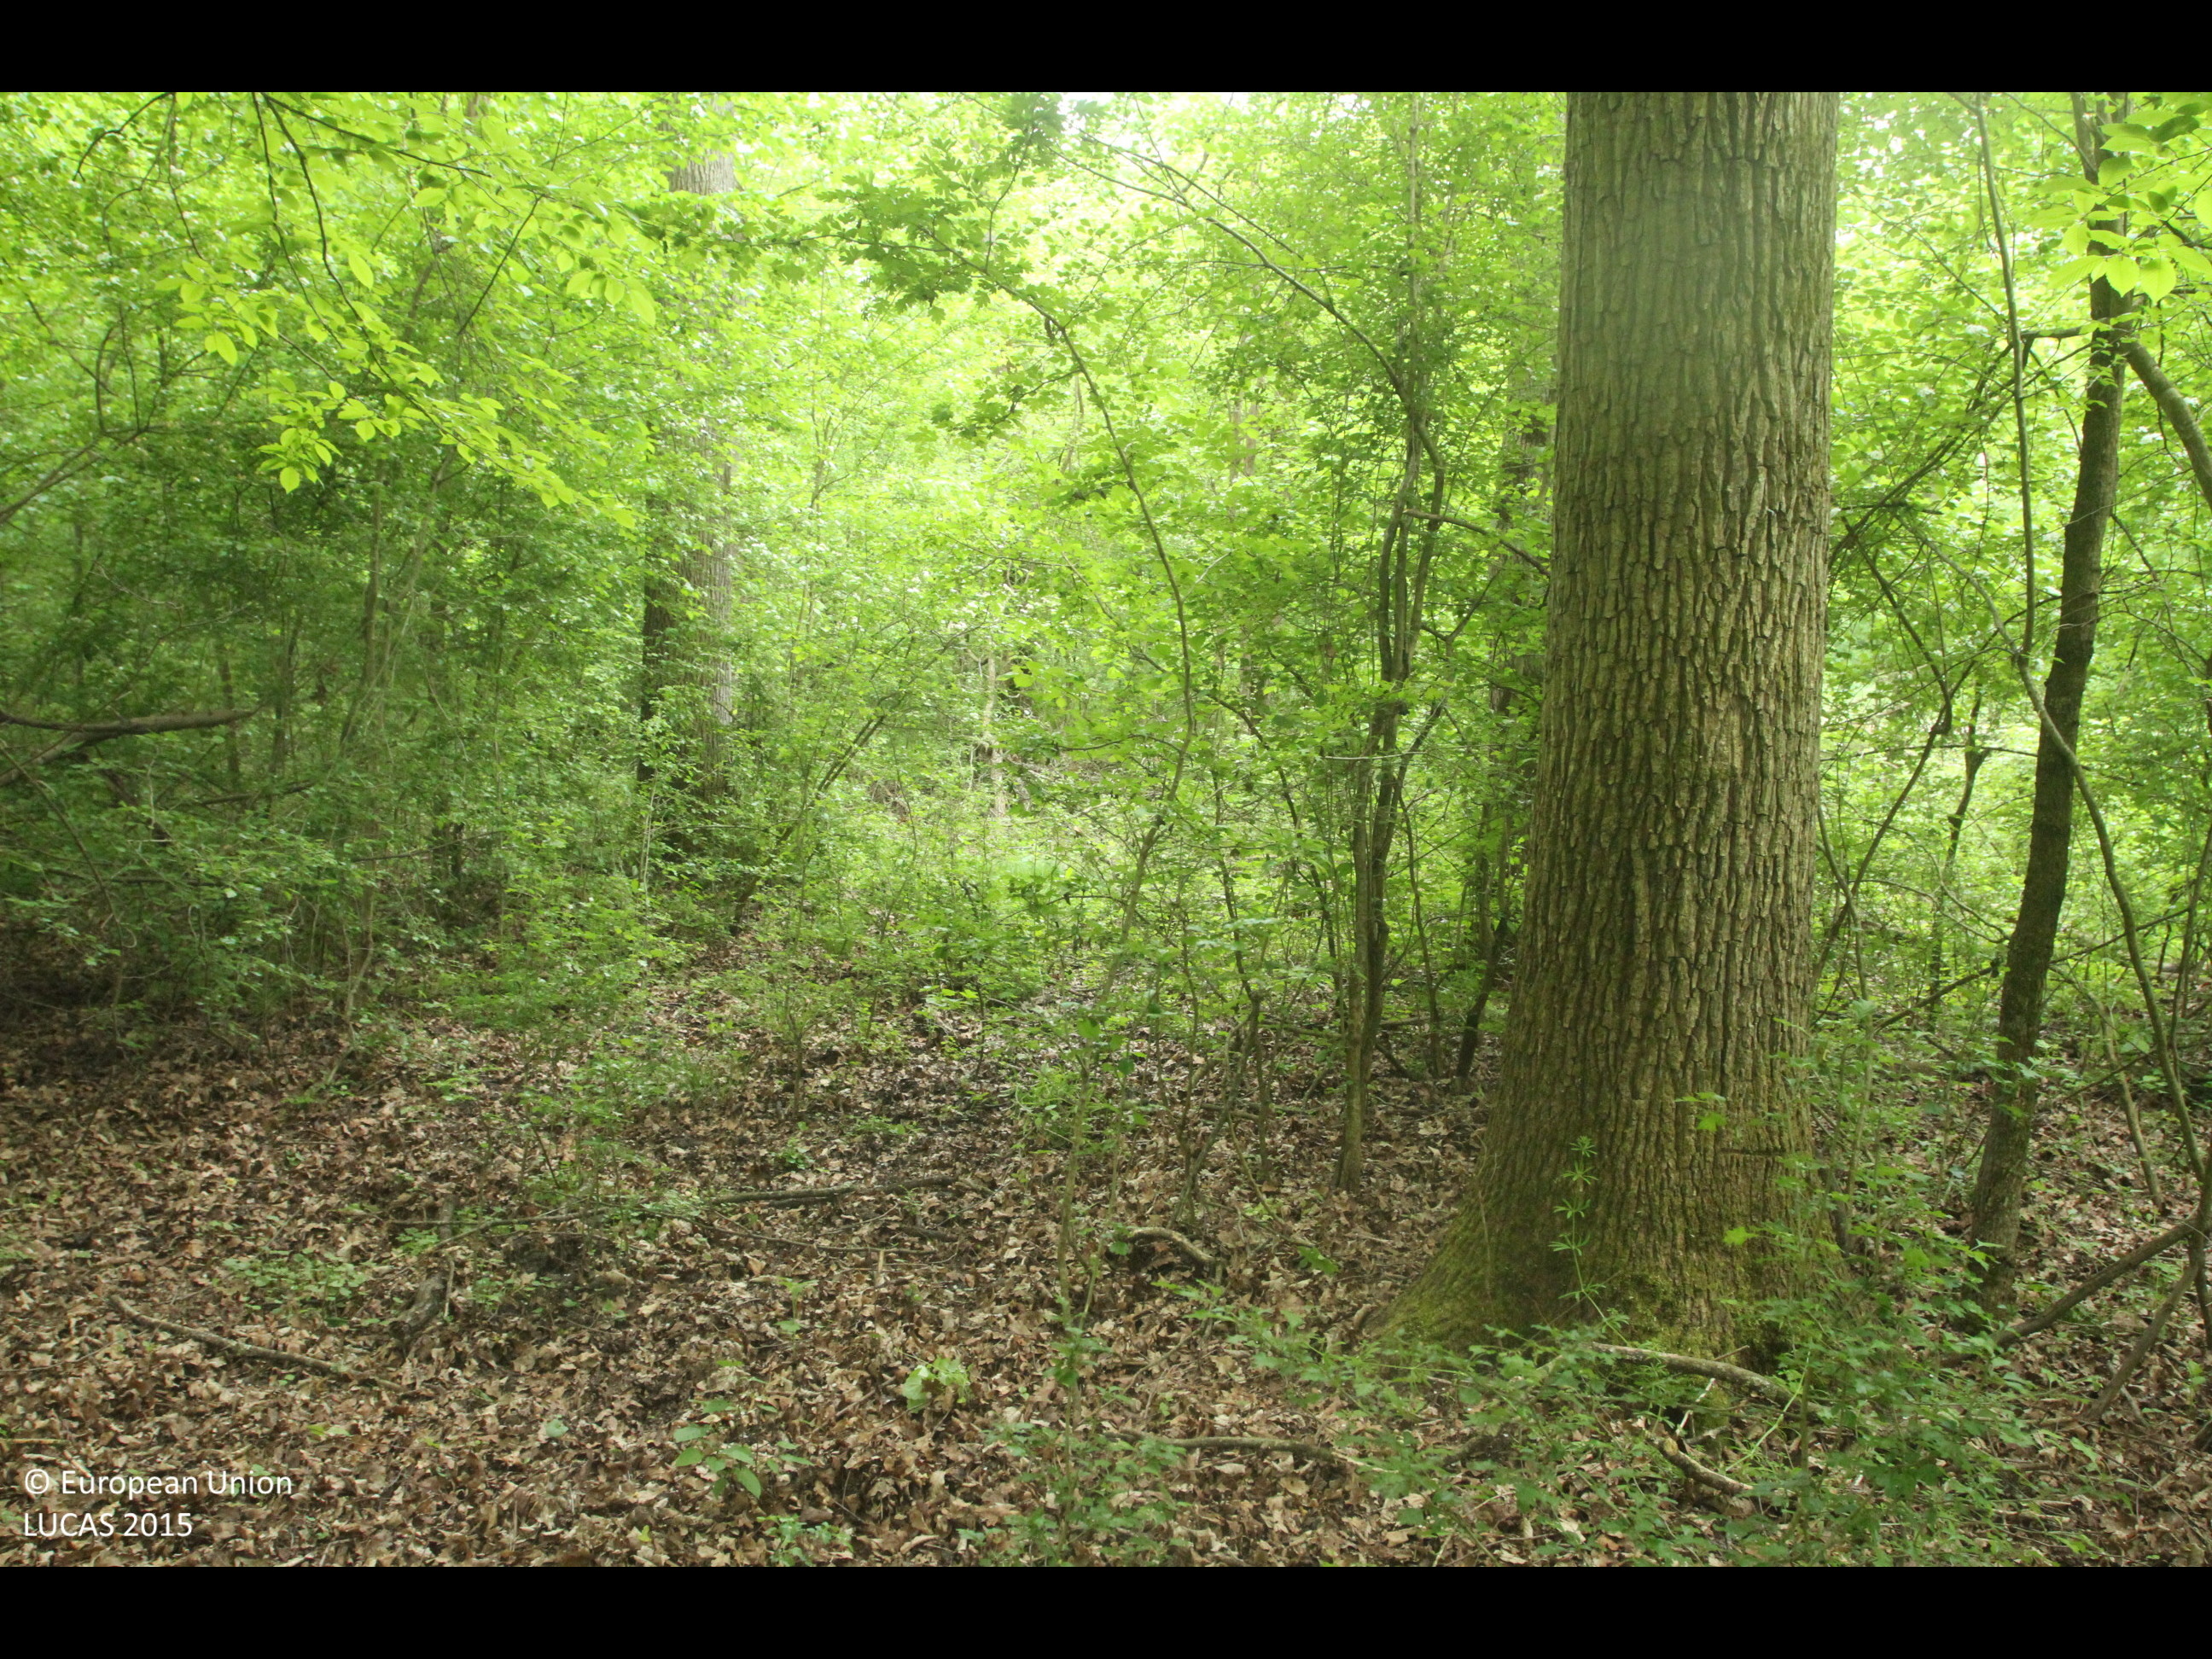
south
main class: Woodland
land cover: Broadleaved woodland
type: mesophytic deciduous forest
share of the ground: > 75 %
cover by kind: broadleaved forest trees 100 %
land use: Forestry
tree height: > 5 m
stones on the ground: < 10 %
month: April
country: HR
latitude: 45.0103
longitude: 19.0031
